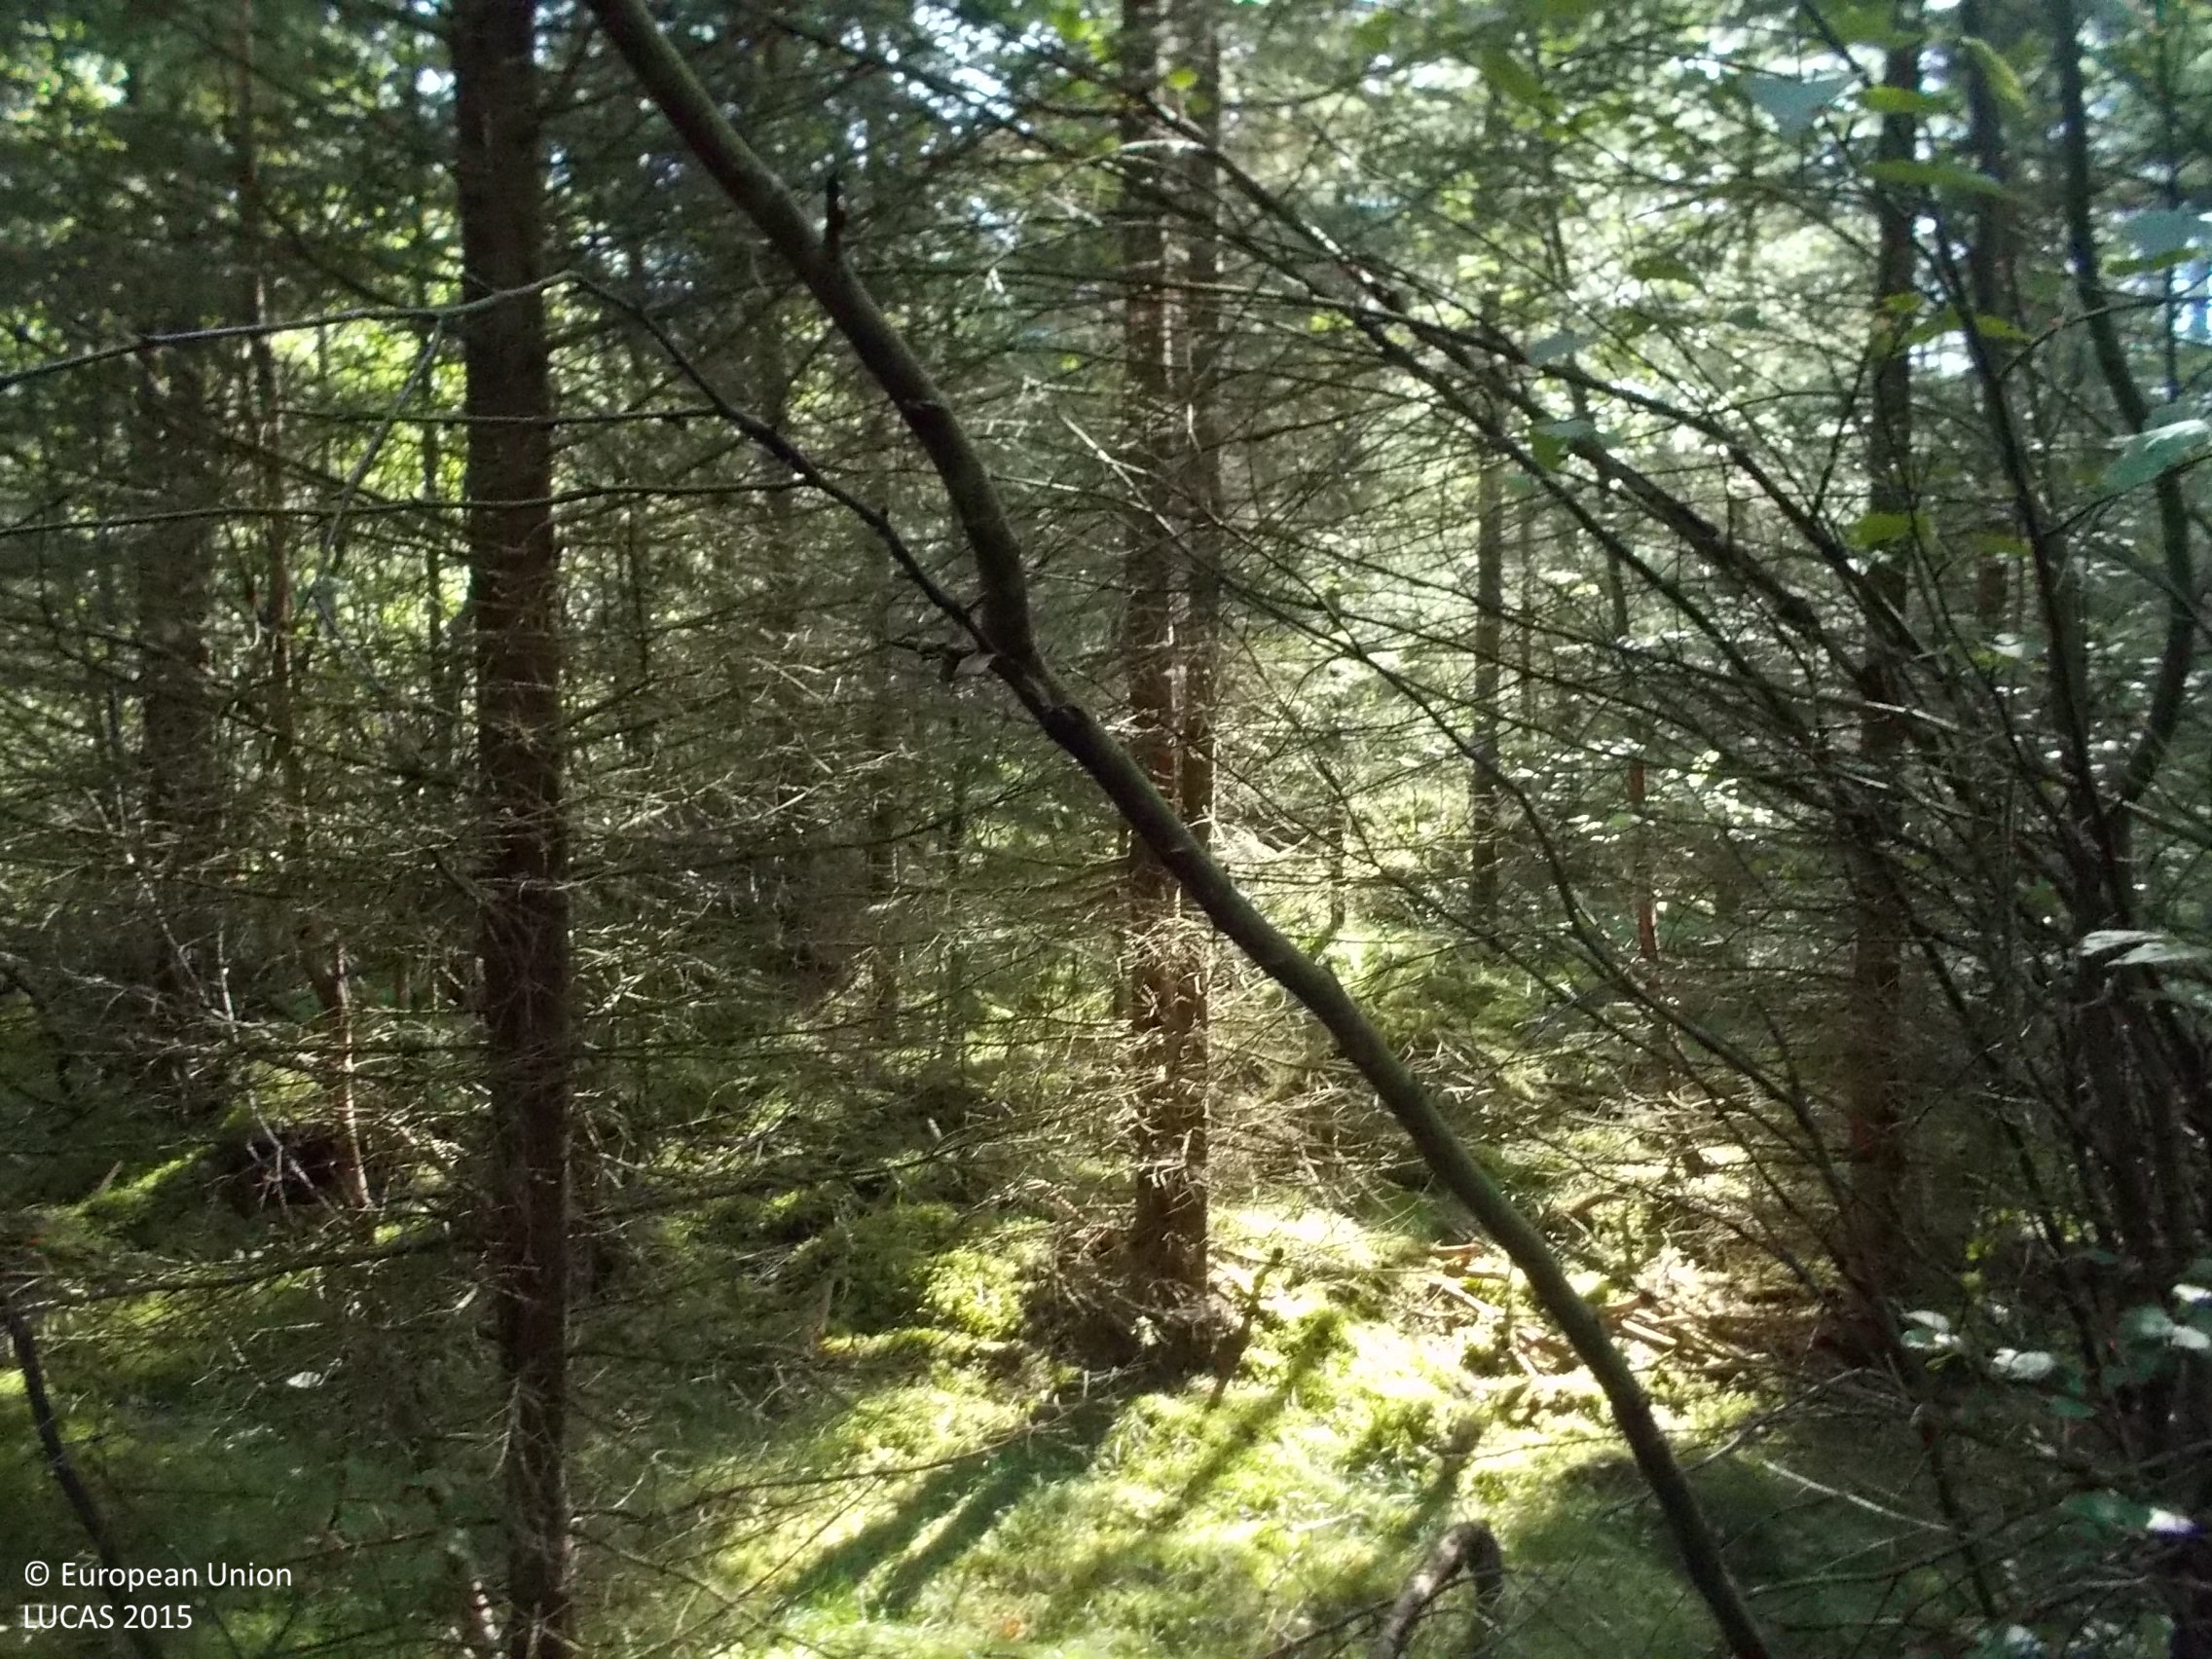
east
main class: Woodland
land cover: Spruce dominated mixed woodland
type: boreal forest
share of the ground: > 75 %
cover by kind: coniferous forest trees 60 %, broadleaved forest trees 30 %, shrubs 5 %, lichens and mosses 5 %
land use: Forestry
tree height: > 5 m
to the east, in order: Spruce dominated mixed woodland; Fences; Spruce dominated coniferous woodland; Tracks; Spruce dominated coniferous woodland; Pine dominated mixed woodland
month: August
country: SE
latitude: 57.6439
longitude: 13.0949
